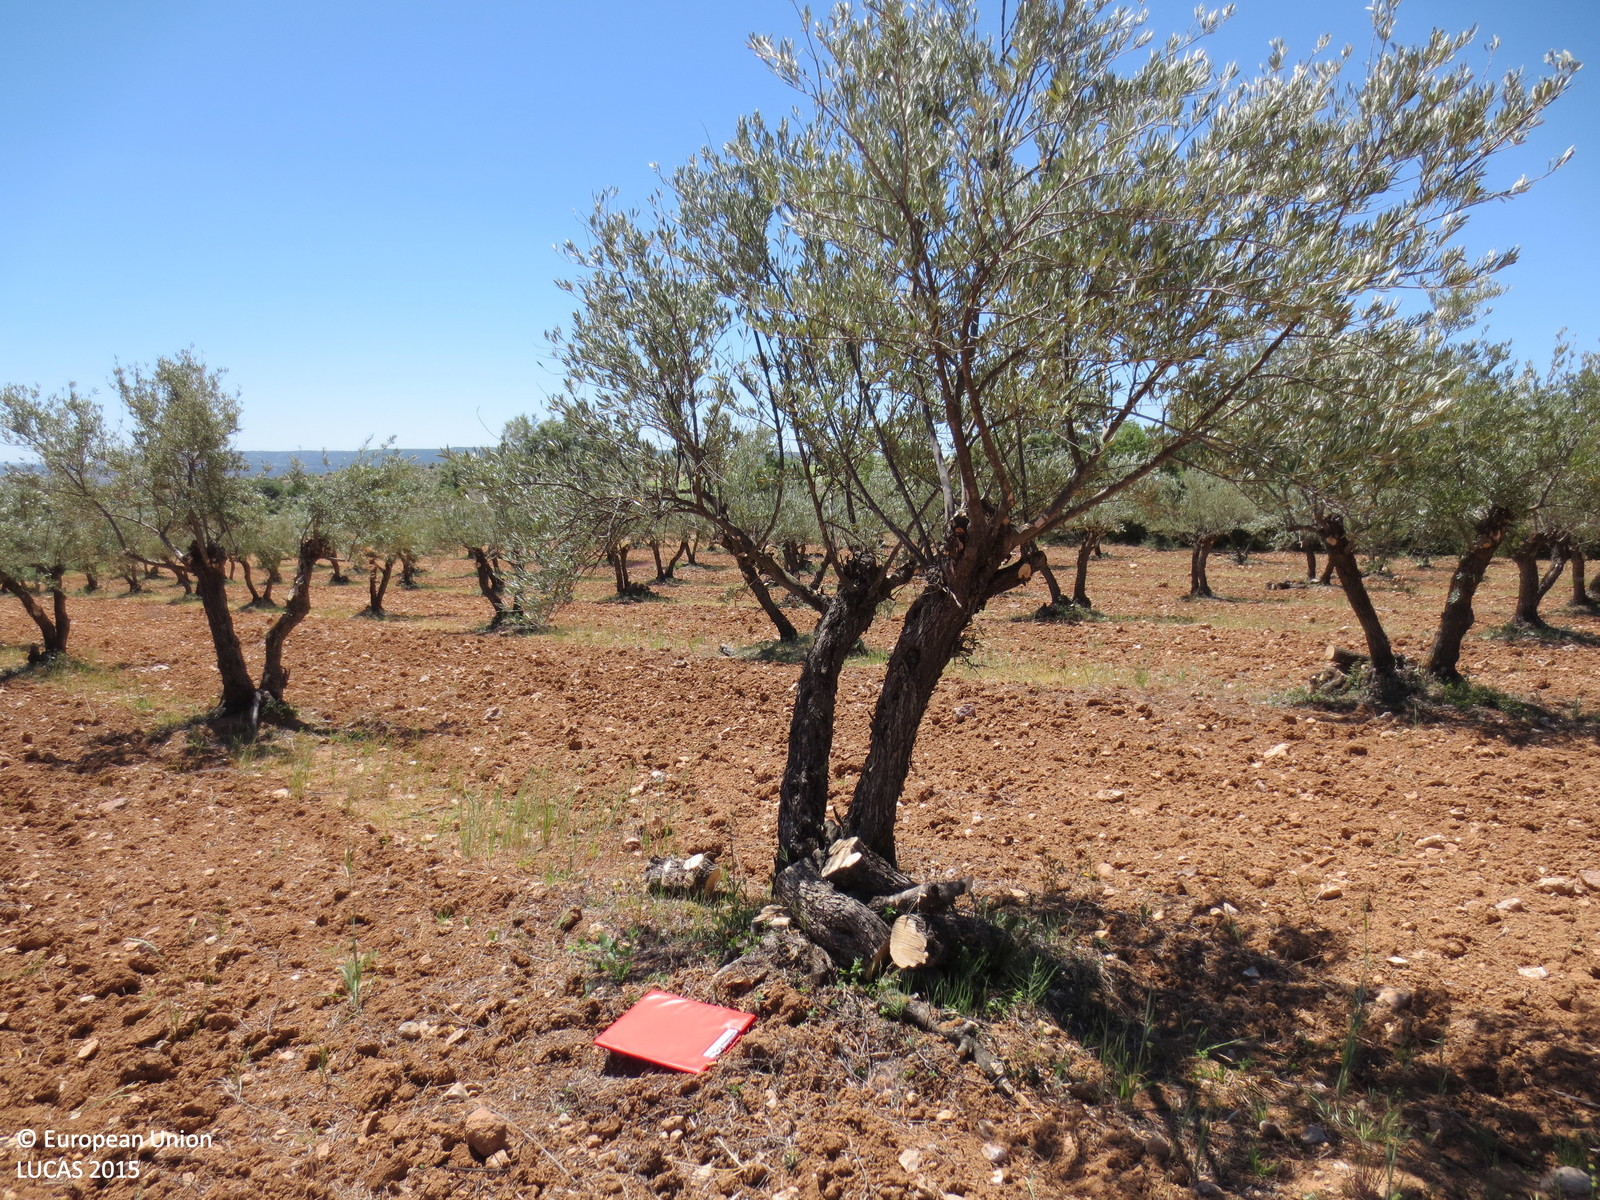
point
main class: Cropland
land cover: Olive groves
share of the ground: 50 - 75 %
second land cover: Other bare soil
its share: > 75 %
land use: Agriculture (excluding fallow land and kitchen gardens)
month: May
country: ES
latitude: 40.4949
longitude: -2.5910
